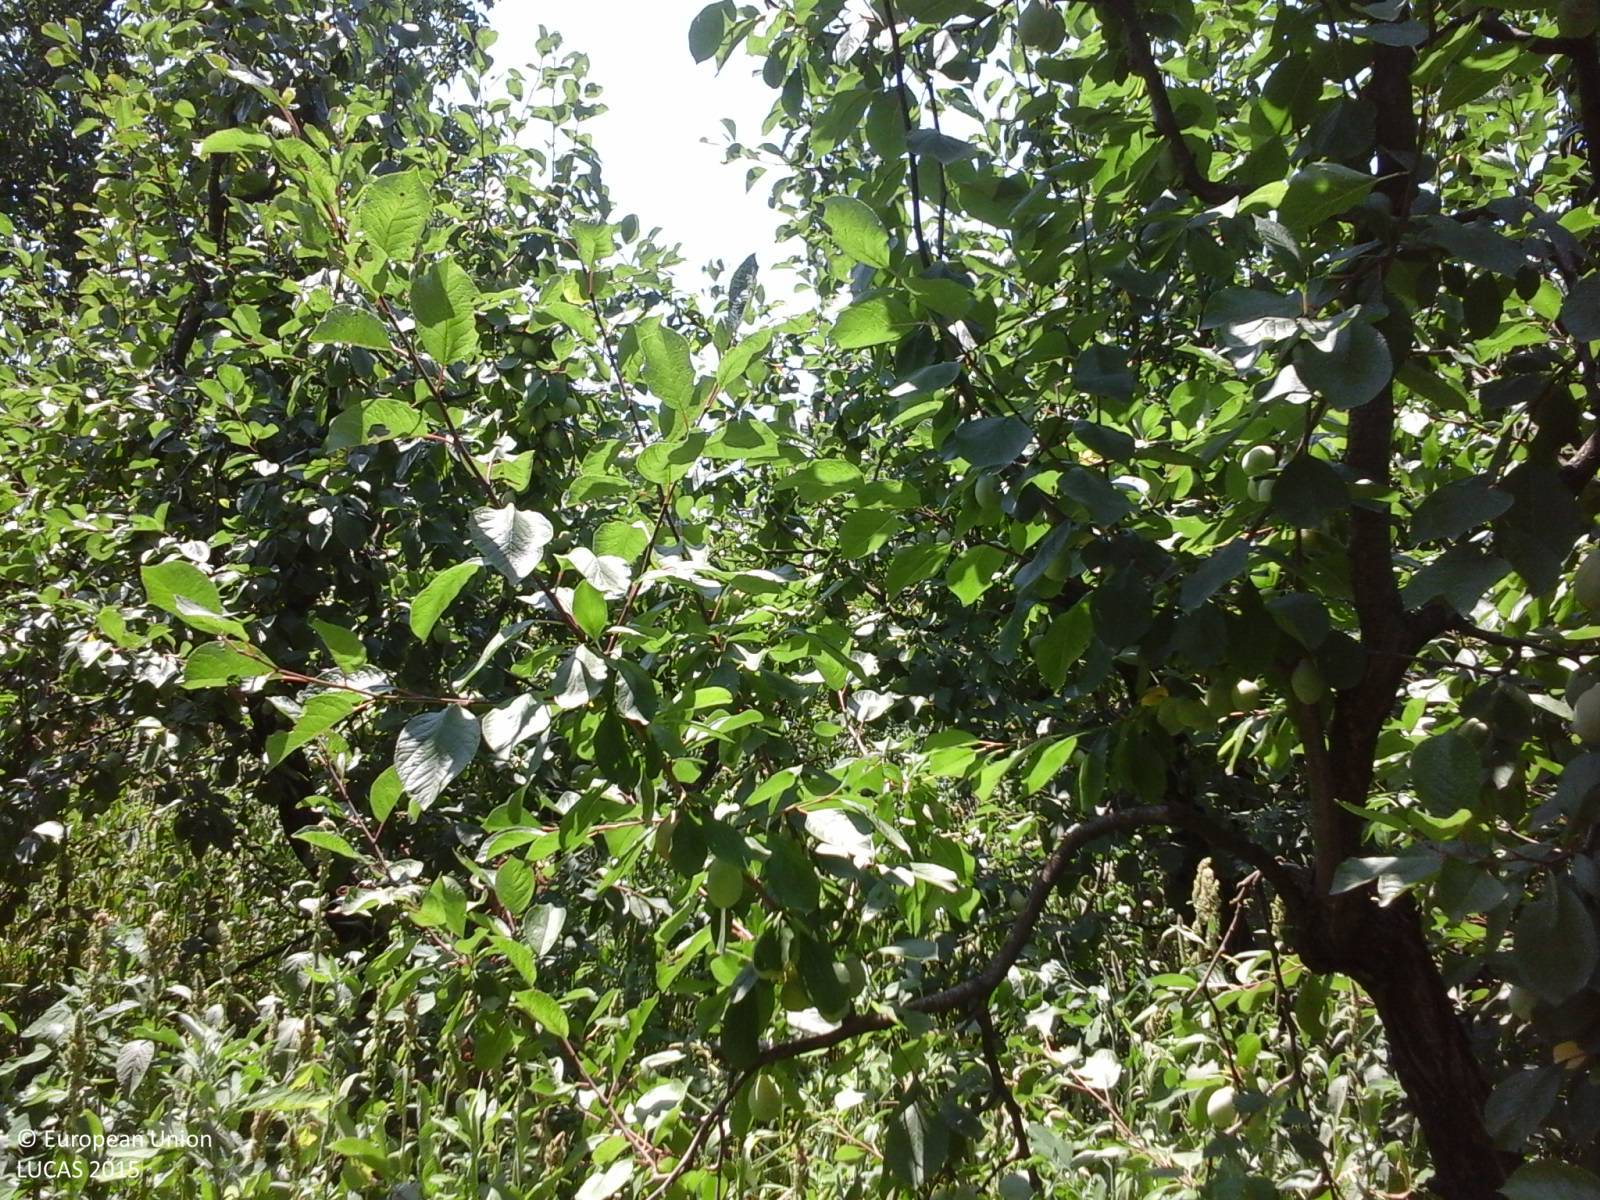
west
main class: Cropland
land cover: Other fruit trees and berries
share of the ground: > 75 %
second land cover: Spontaneously vegetated surfaces
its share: > 75 %
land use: Agriculture (excluding fallow land and kitchen gardens)
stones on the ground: < 10 %
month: July
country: IT
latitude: 40.8861
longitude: 14.1484
